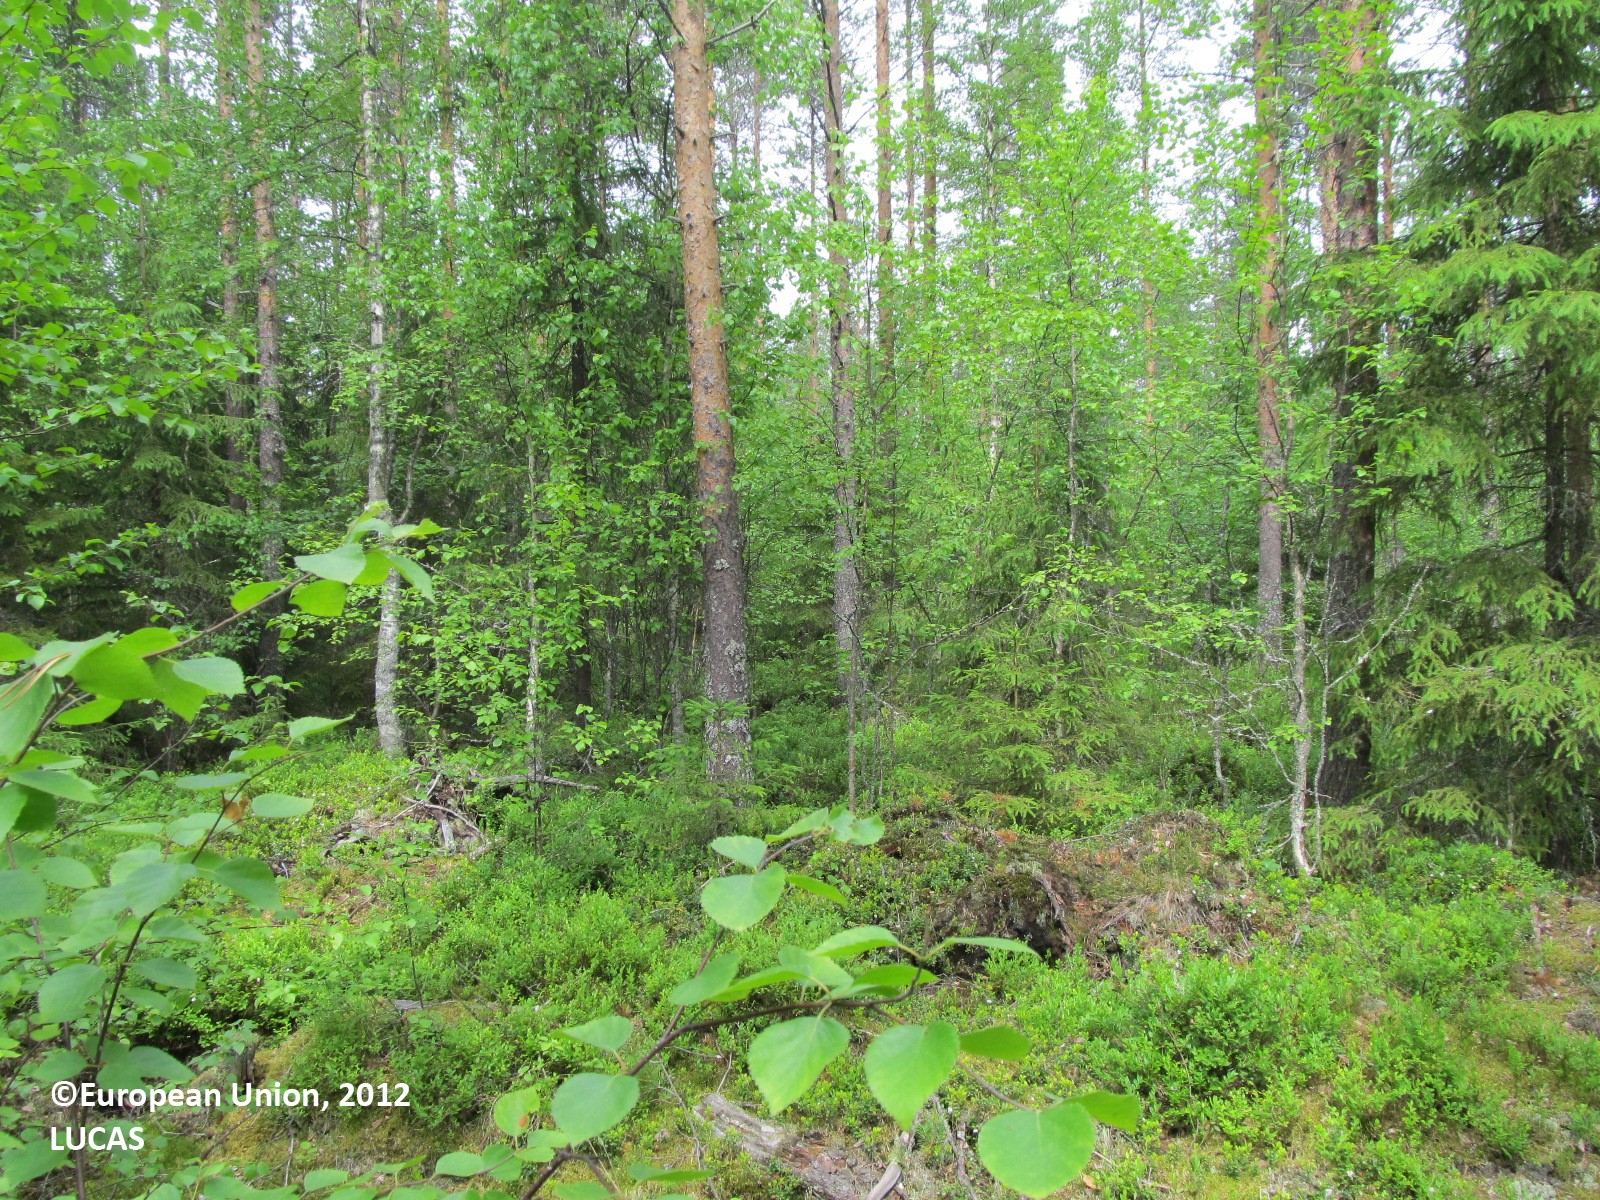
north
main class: Woodland
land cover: Pine dominated mixed woodland
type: boreal forest
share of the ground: 50 - 75 %
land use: Forestry
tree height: > 5 m
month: June
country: FI
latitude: 62.8211
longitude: 28.9958
